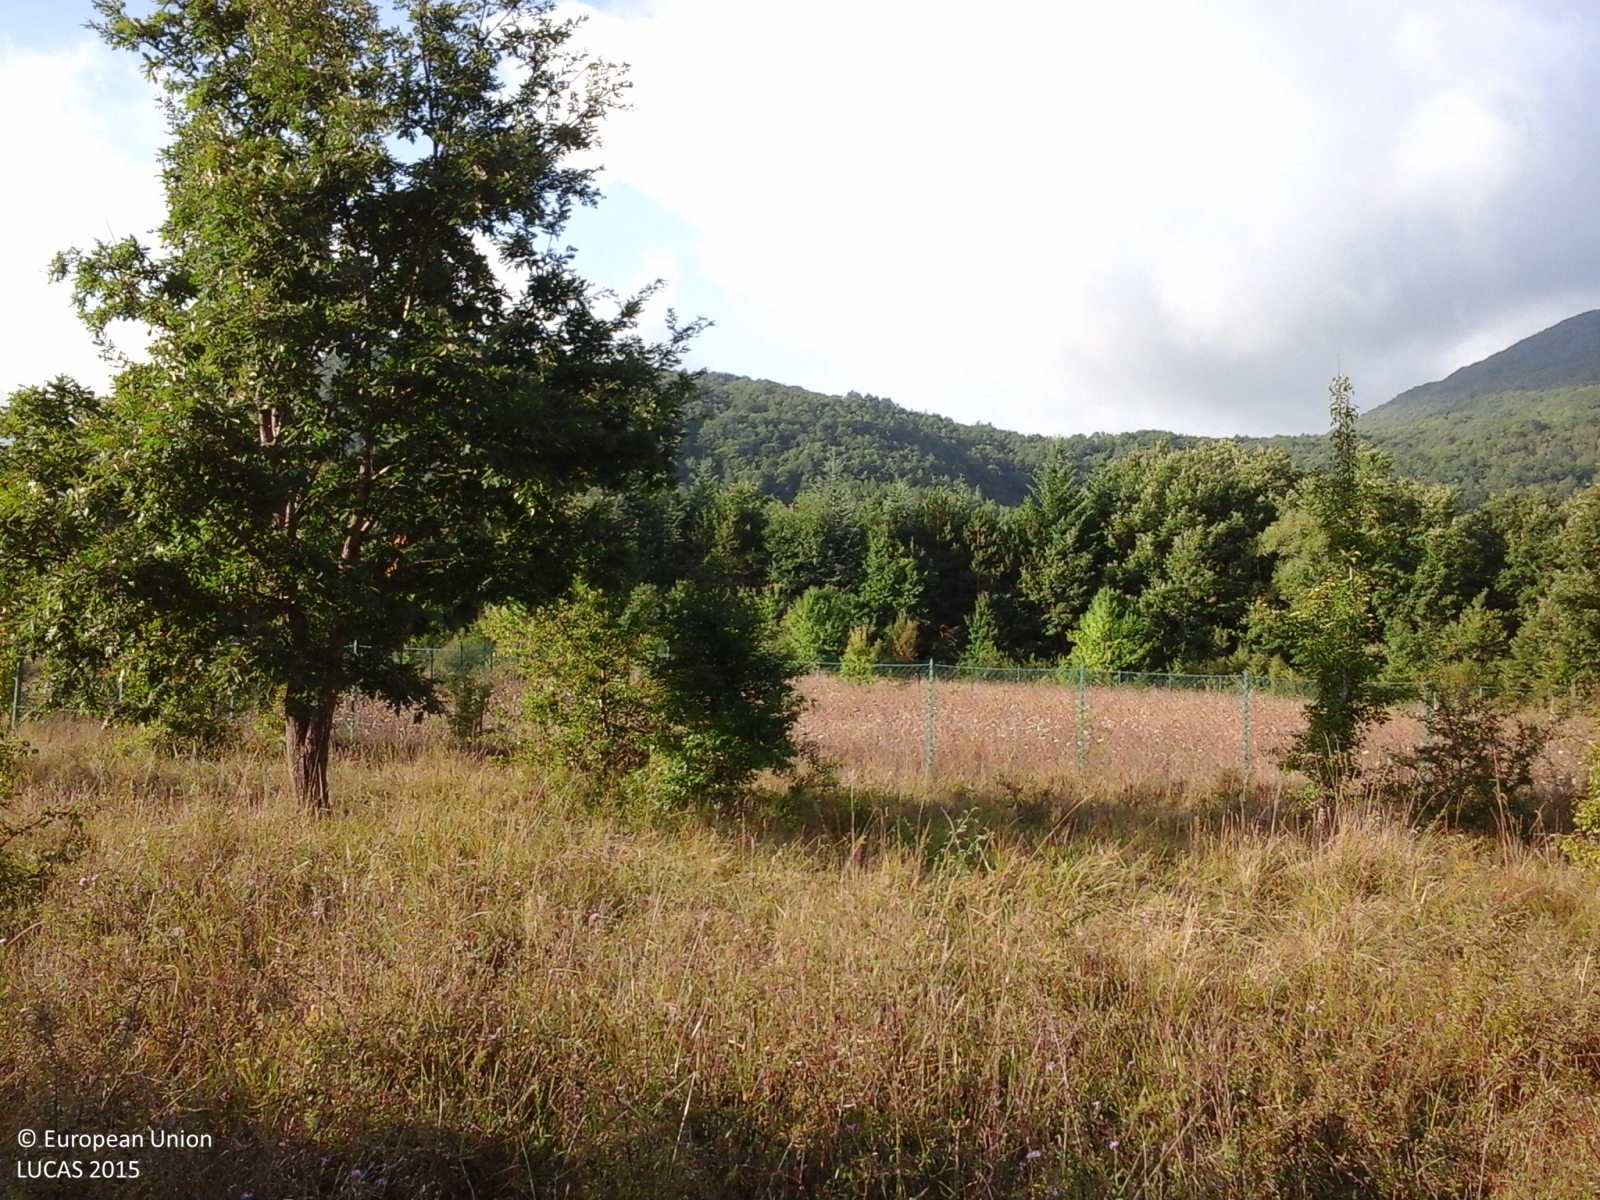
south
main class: Shrubland
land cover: Shrubland with sparse tree cover
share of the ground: > 75 %
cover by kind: shrubs 90 %, broadleaved forest trees 5 %, herbaceous plants 5 %
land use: Semi-natural and natural areas not in use
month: August
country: IT
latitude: 41.6743
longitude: 14.3451
